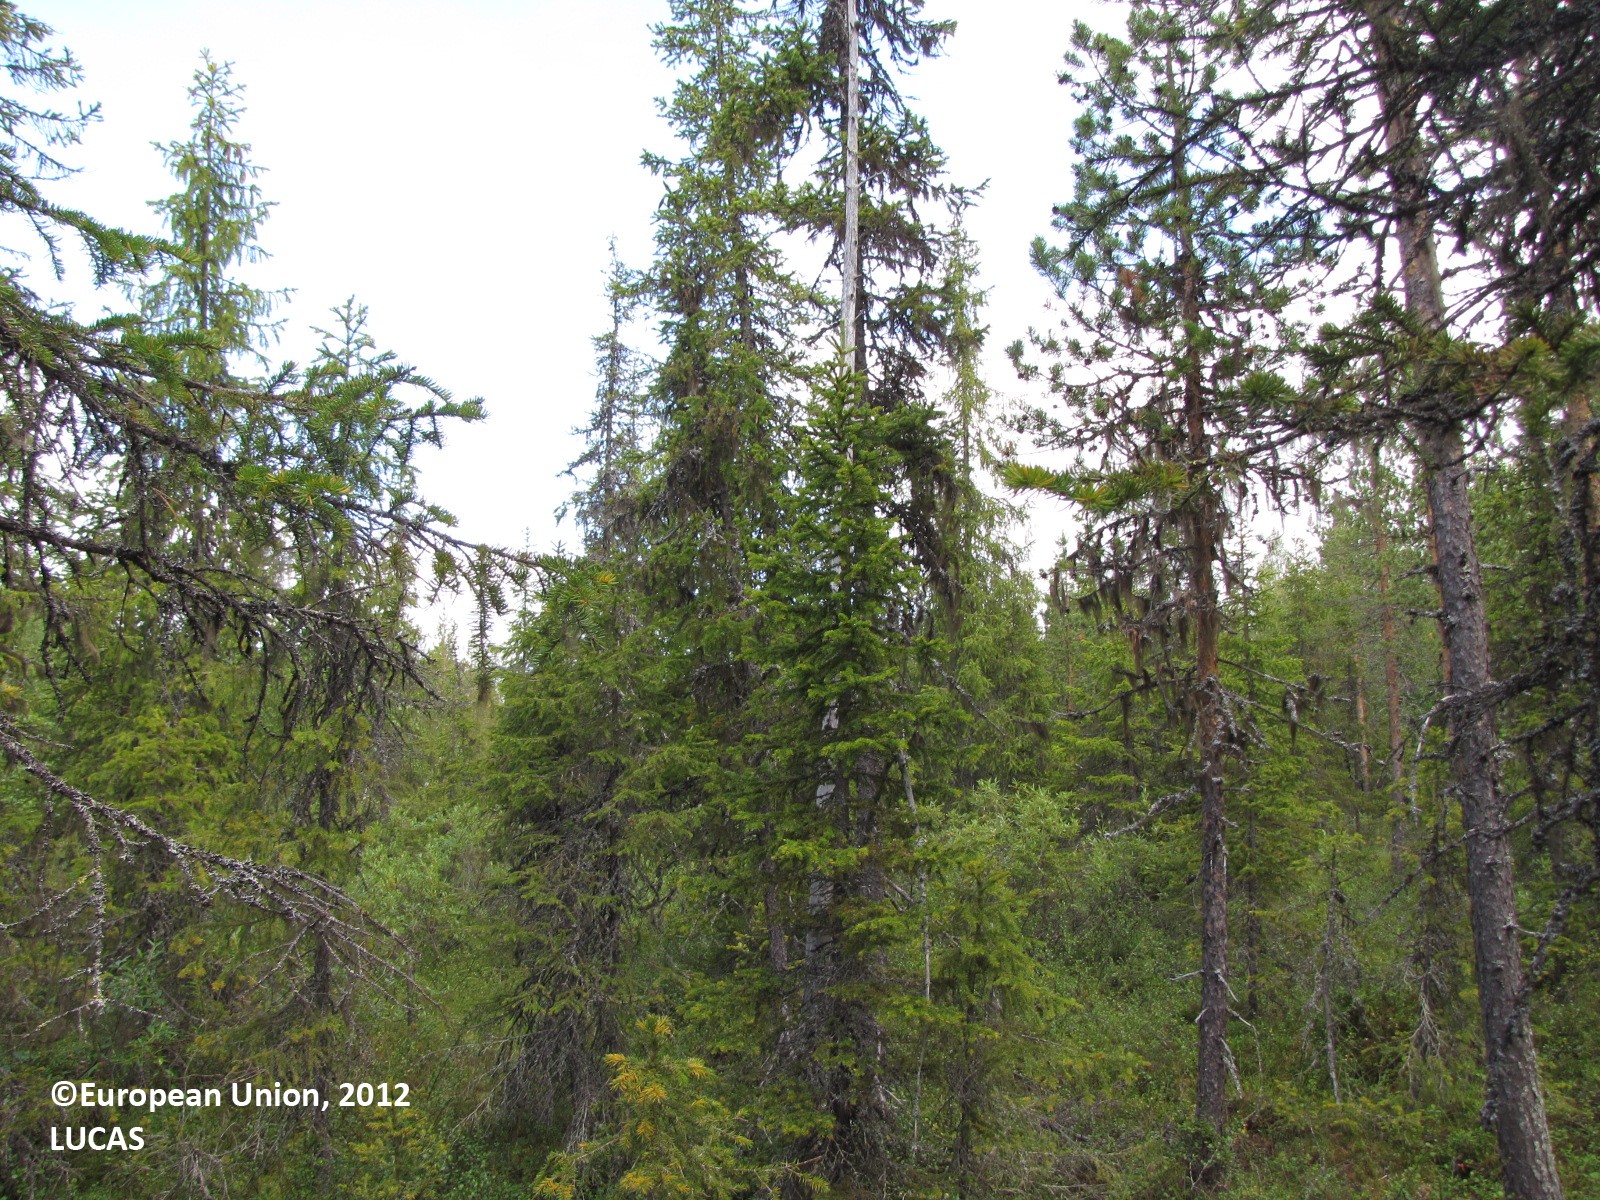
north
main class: Woodland
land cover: Spruce dominated coniferous woodland
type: boreal forest
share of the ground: 25 - 50 %
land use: Forestry
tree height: > 5 m
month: August
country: FI
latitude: 66.8599
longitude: 24.5667
